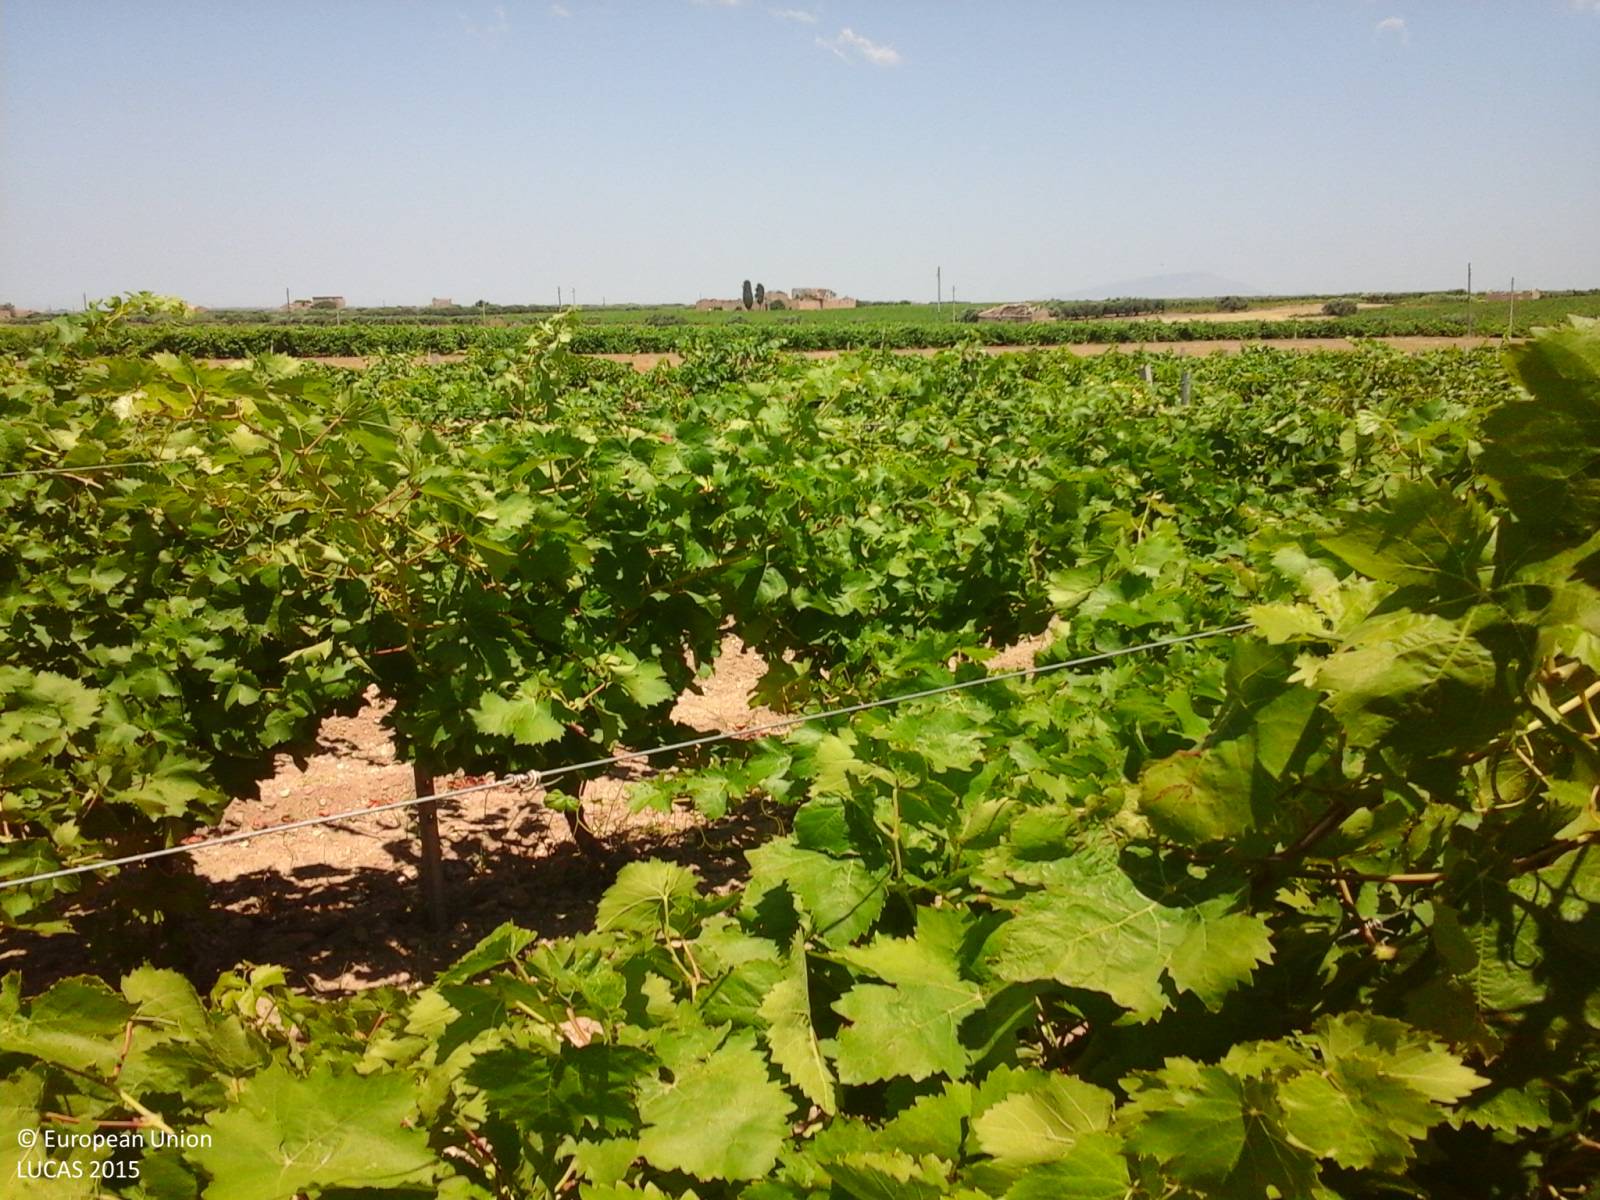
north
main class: Cropland
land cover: Vineyards
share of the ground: 50 - 75 %
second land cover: Other bare soil
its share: > 75 %
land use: Agriculture (excluding fallow land and kitchen gardens)
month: July
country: IT
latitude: 37.7670
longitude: 12.5803
